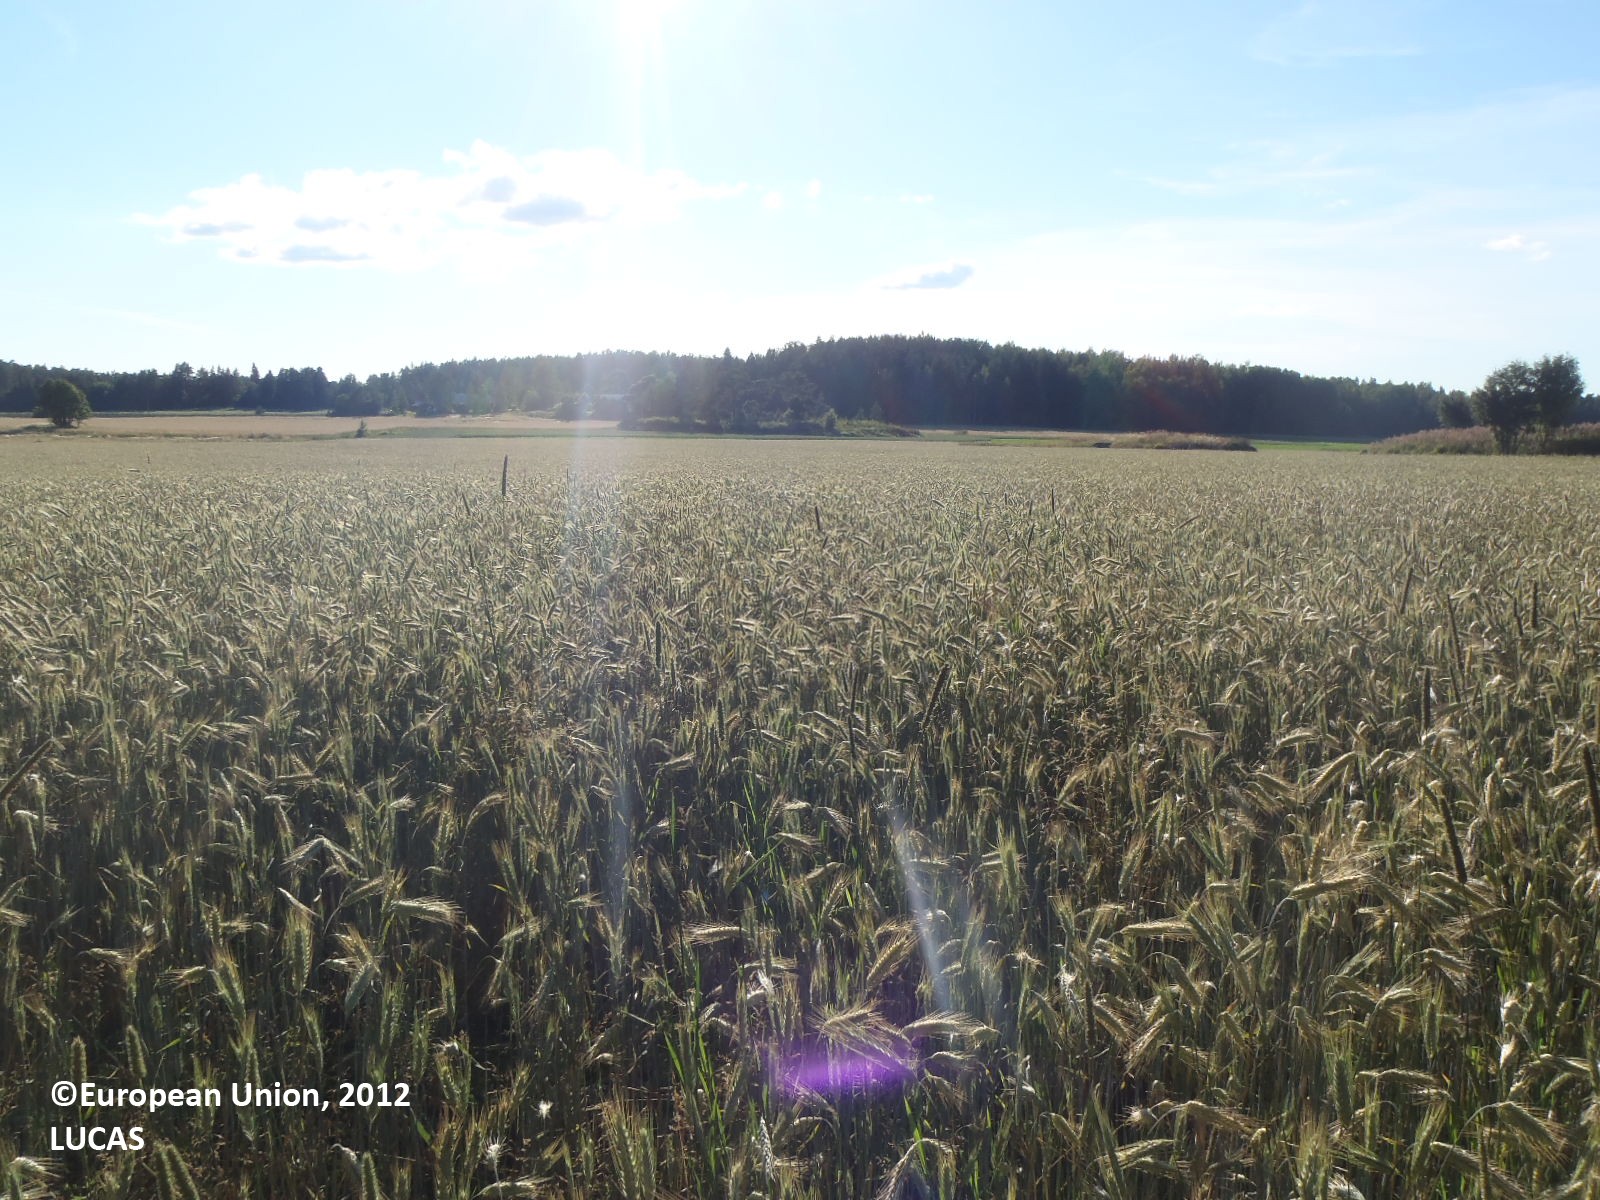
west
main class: Cropland
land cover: Mixed cereals for fodder
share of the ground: > 75 %
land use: Agriculture (excluding fallow land and kitchen gardens)
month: July
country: FI
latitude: 60.6038
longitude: 21.9146
